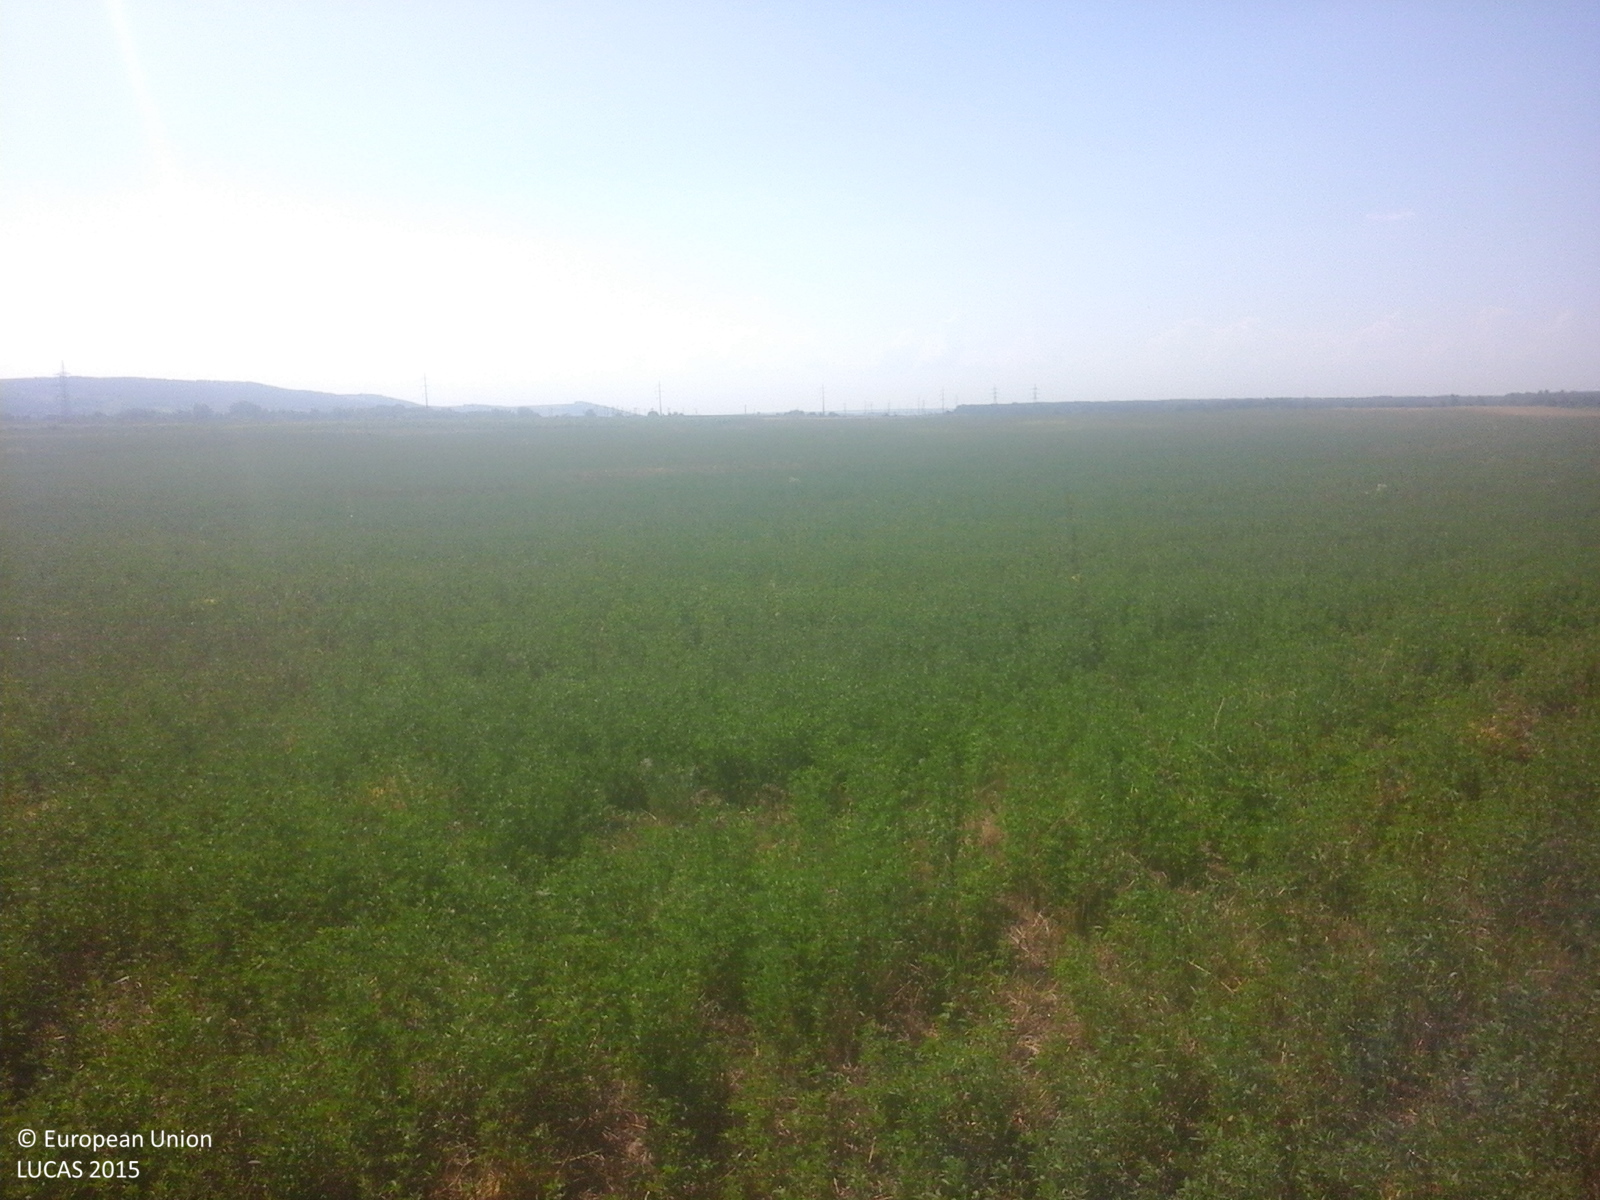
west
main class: Cropland
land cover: Lucerne
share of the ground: > 75 %
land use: Agriculture (excluding fallow land and kitchen gardens)
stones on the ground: < 10 %
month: June
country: RO
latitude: 47.2747
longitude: 27.6905
